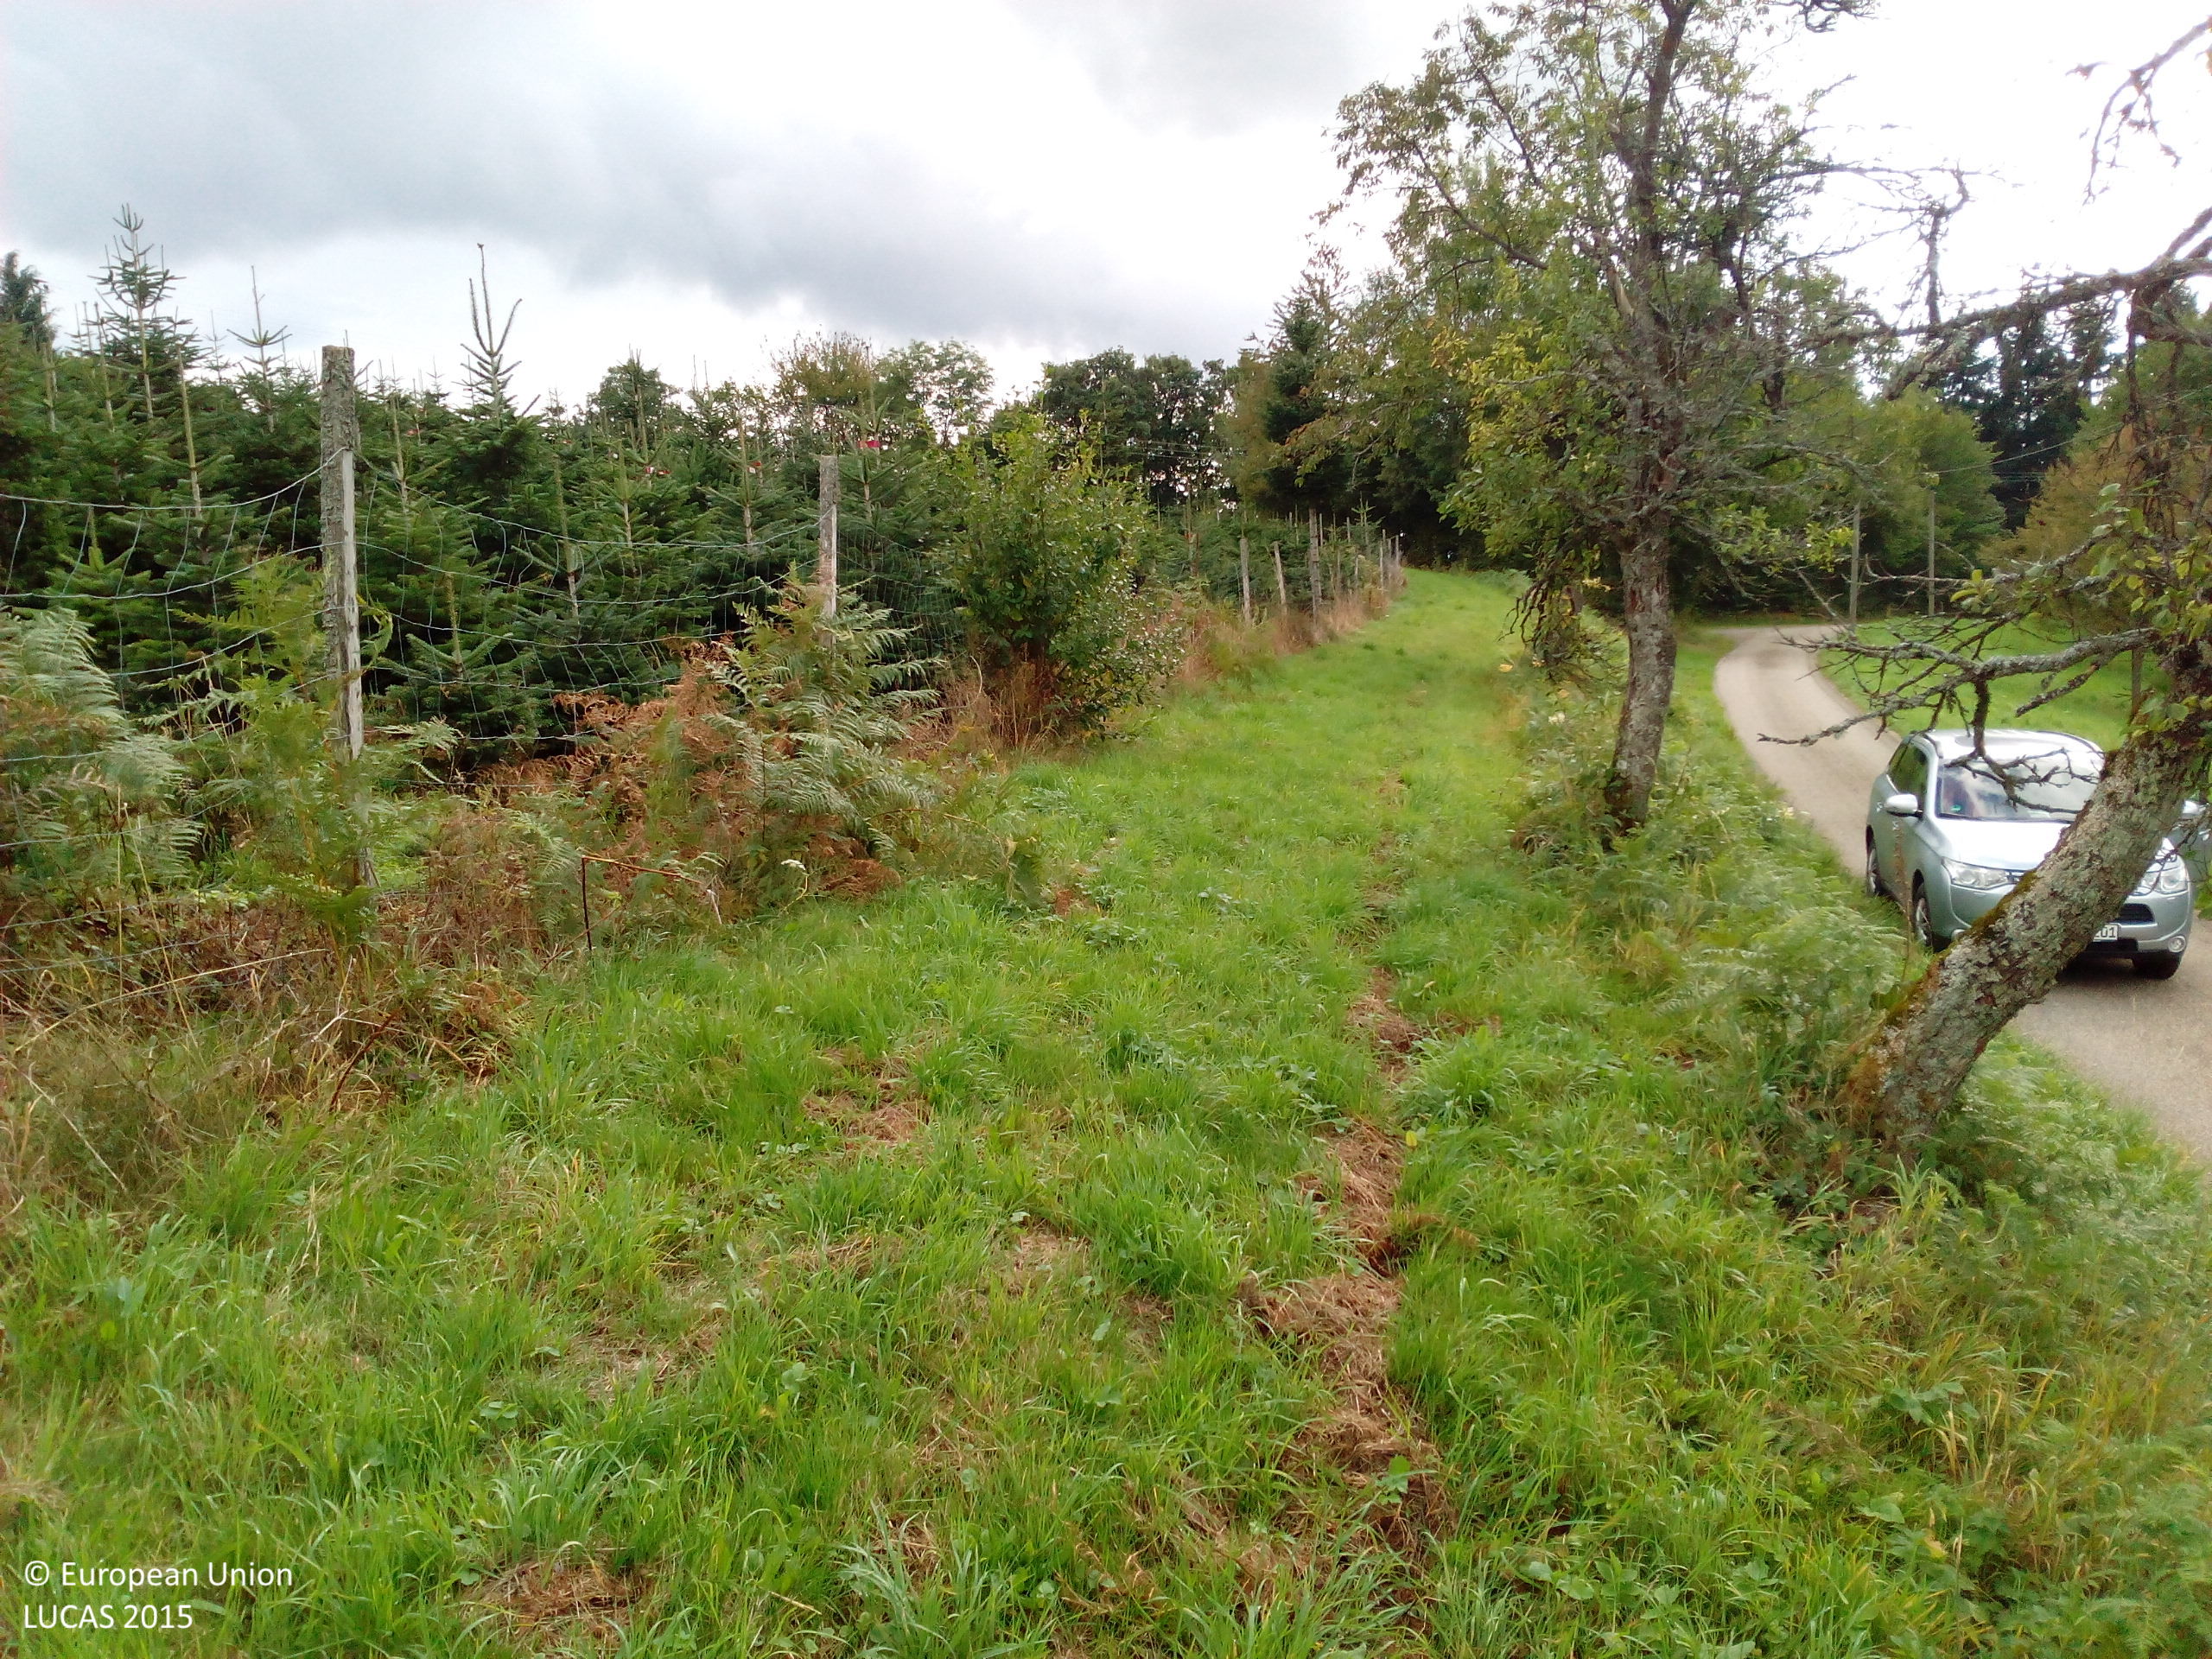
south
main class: Cropland
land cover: Other fruit trees and berries
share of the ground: 10 - 25 %
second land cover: Grassland without tree/shrub cover
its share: > 75 %
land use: Agriculture (excluding fallow land and kitchen gardens)
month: September
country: DE
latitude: 48.3332
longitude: 8.0989
